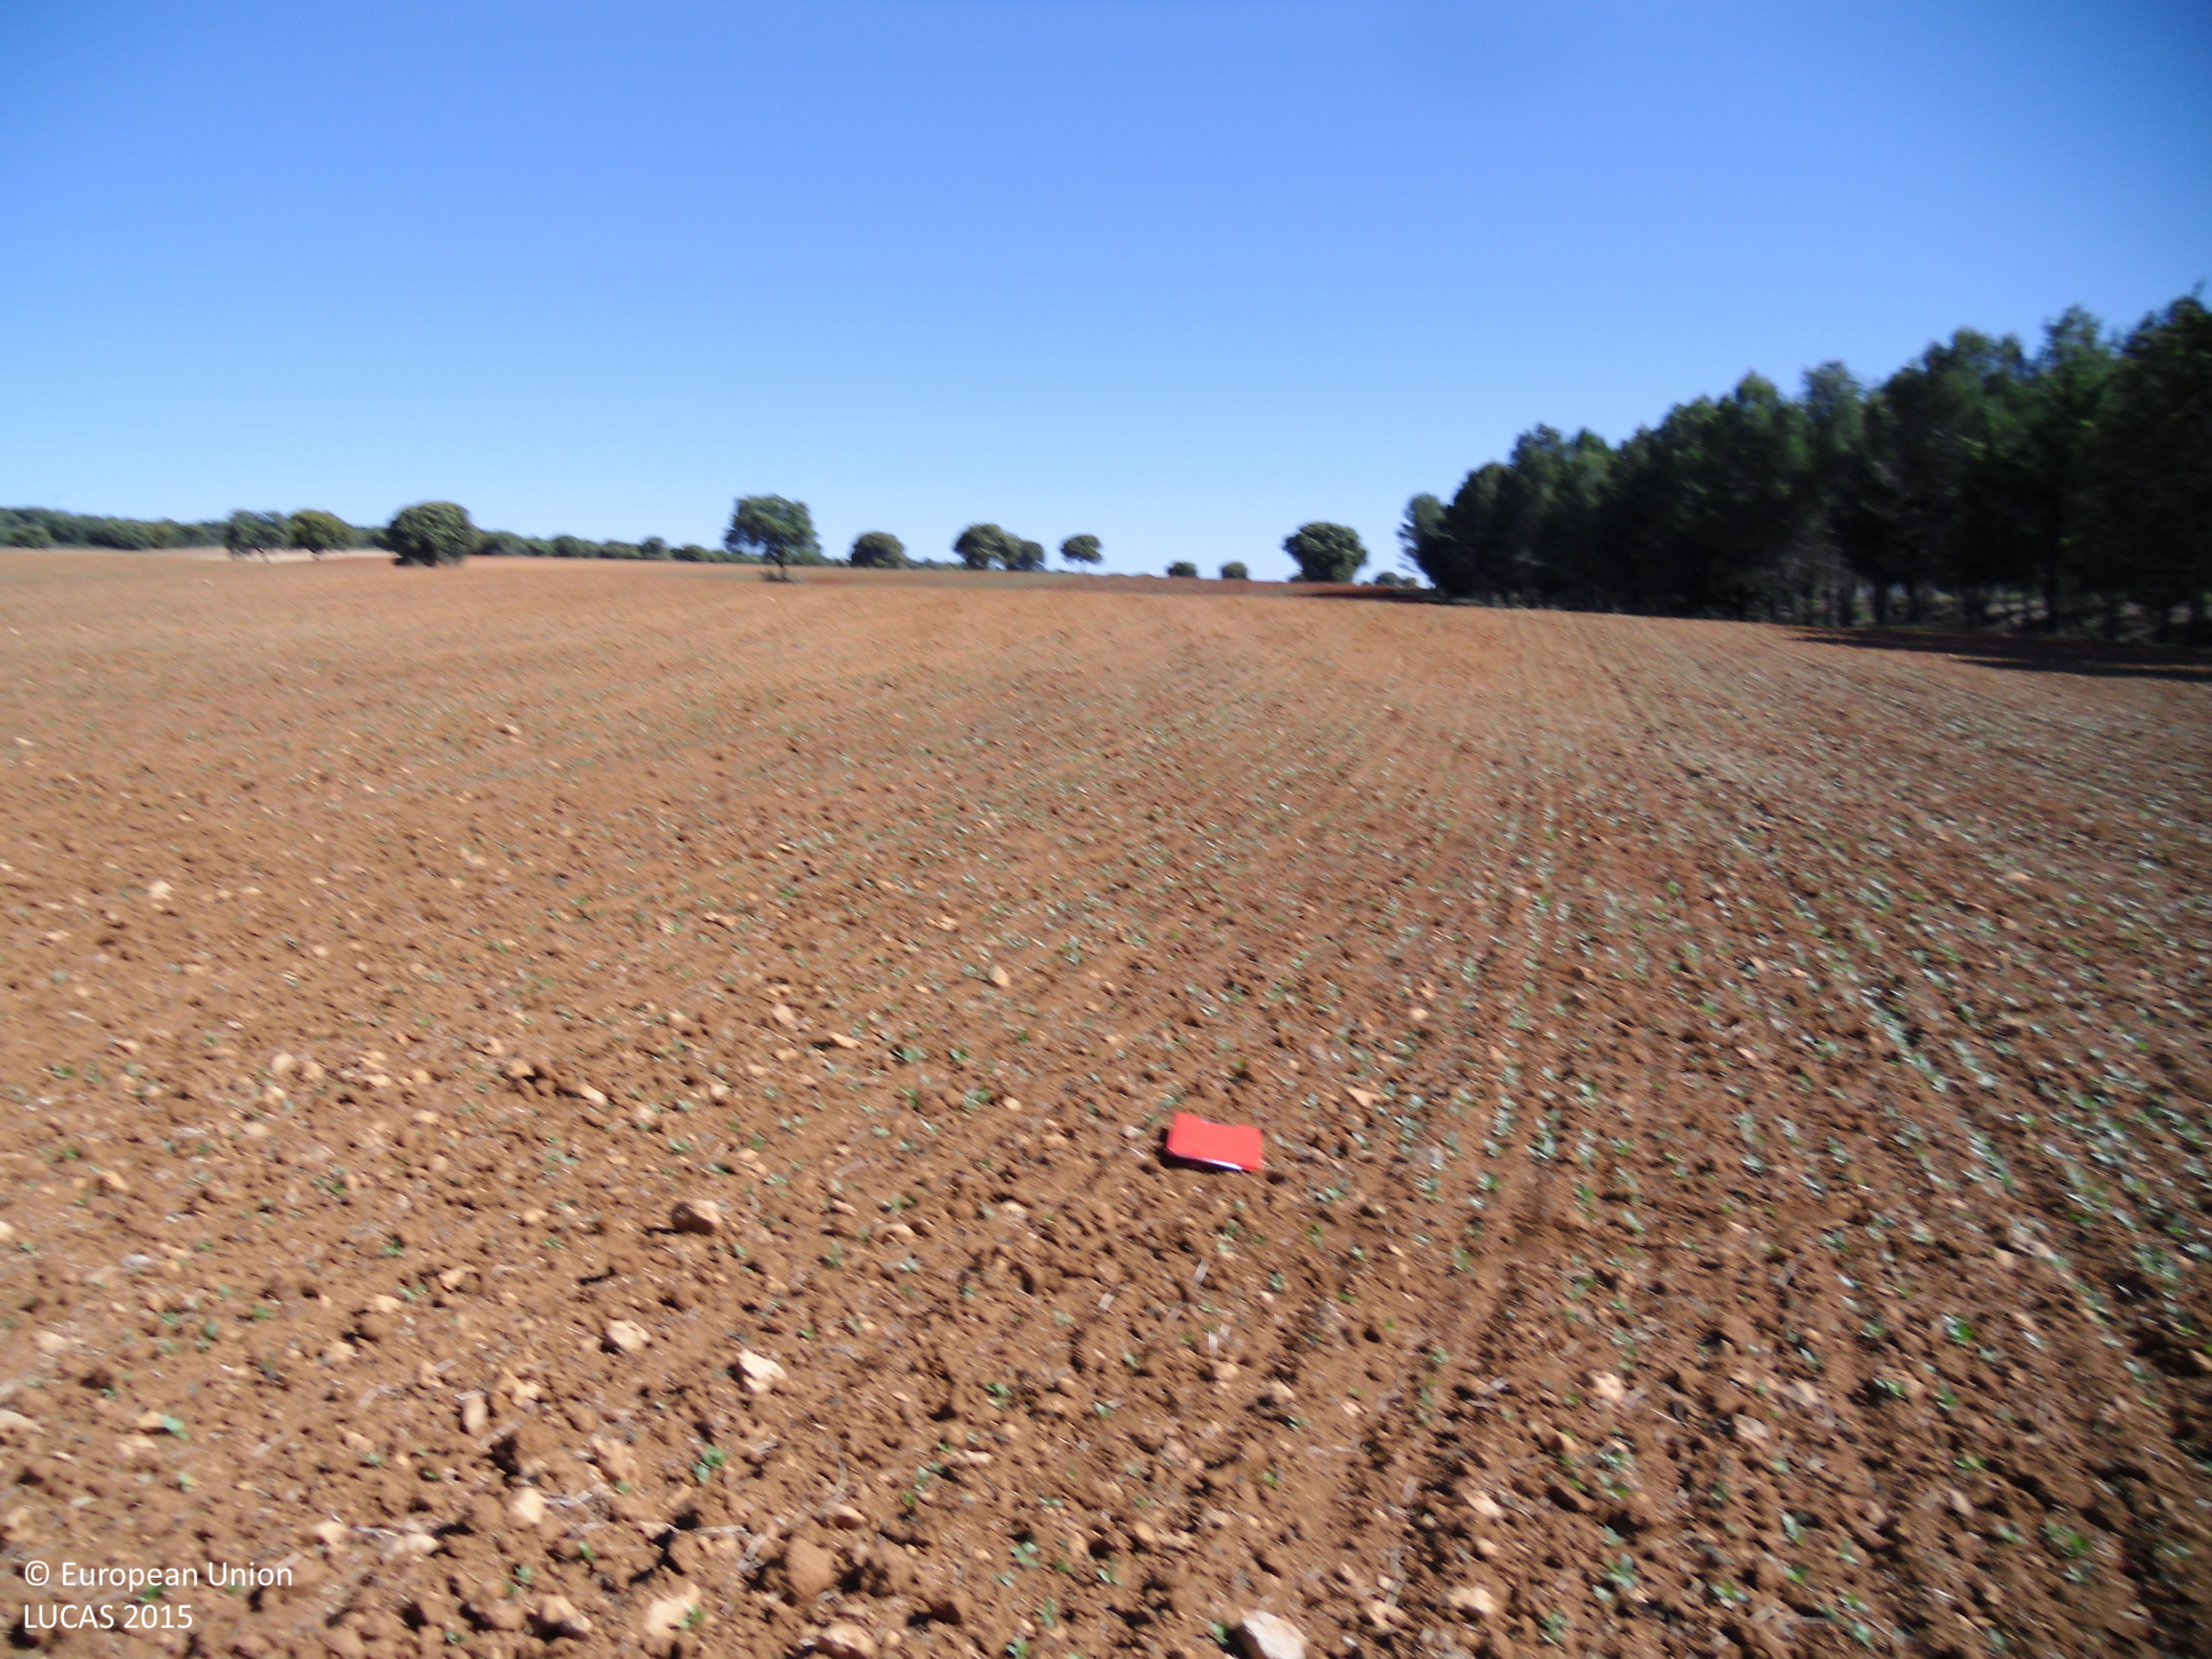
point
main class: Cropland
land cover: Soya
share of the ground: < 10 %
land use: Agriculture (excluding fallow land and kitchen gardens)
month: May
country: ES
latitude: 40.2031
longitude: -2.8654
